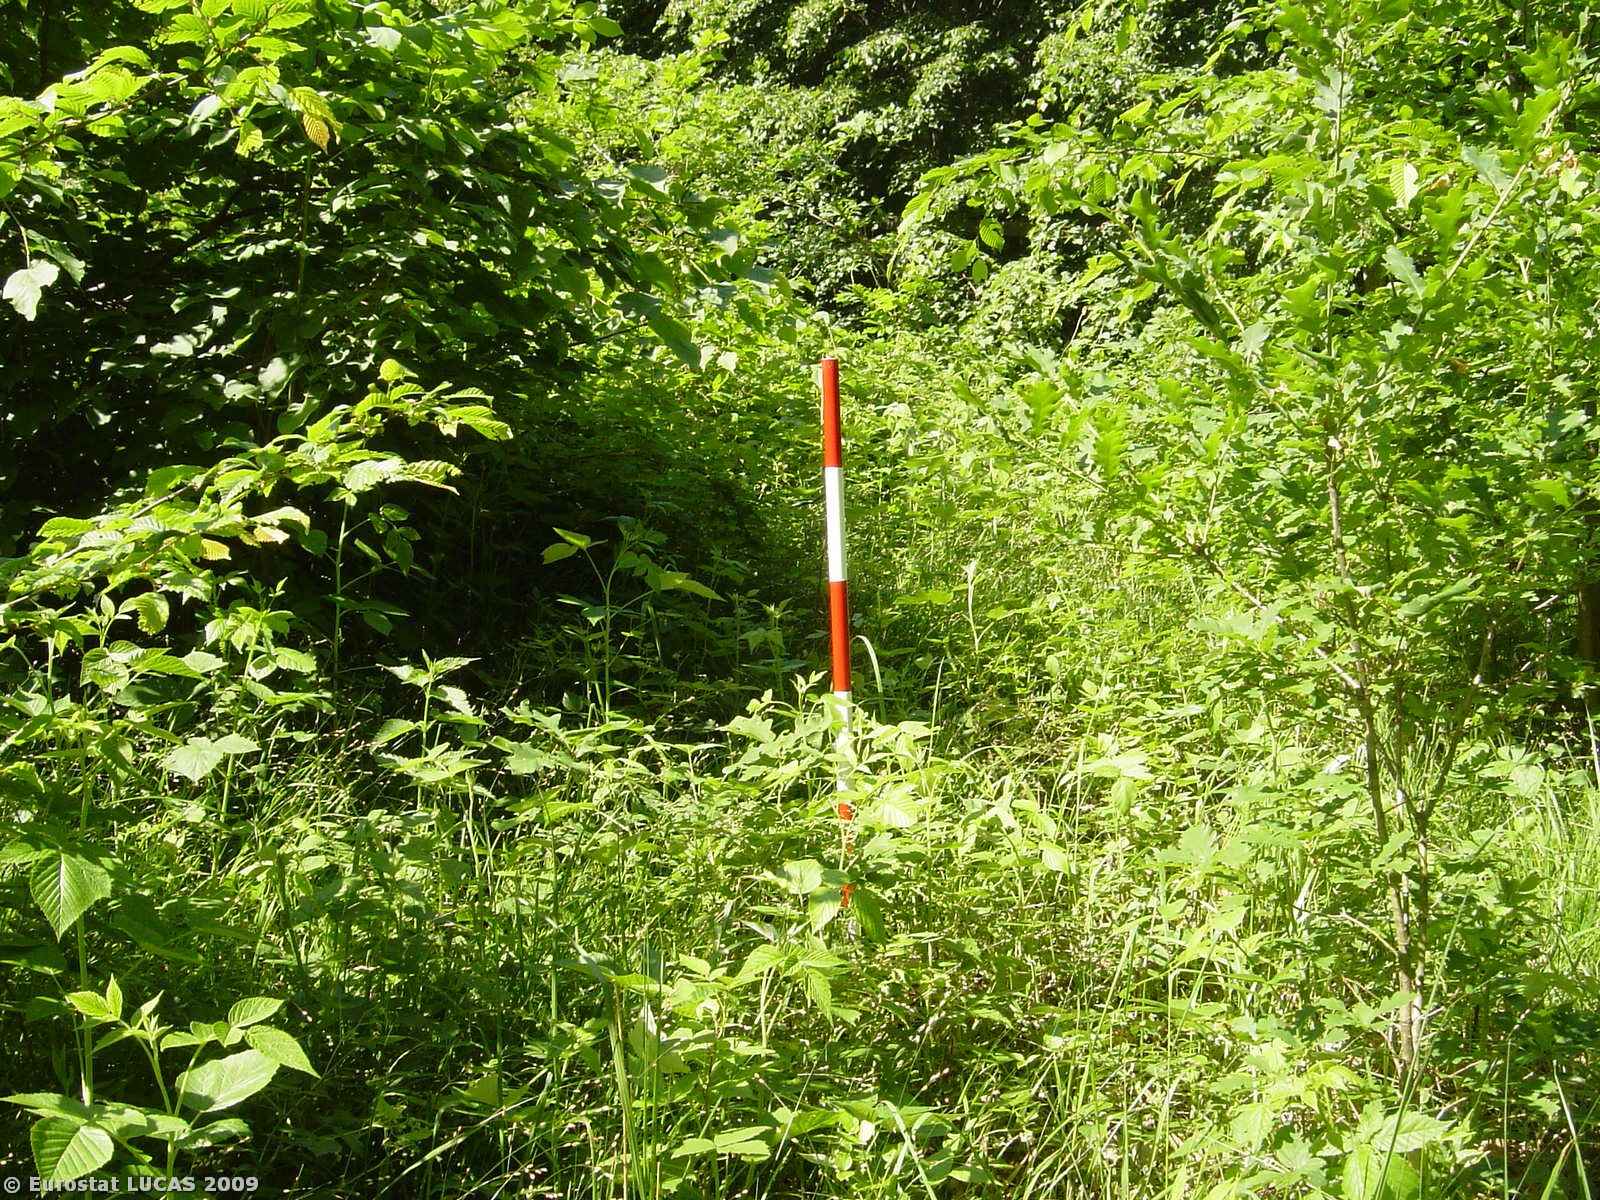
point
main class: Woodland
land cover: Broadleaved woodland
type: mesophytic deciduous forest
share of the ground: > 75 %
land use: Forestry
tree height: > 5 m
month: May
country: CZ
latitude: 49.0772
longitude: 17.1147
